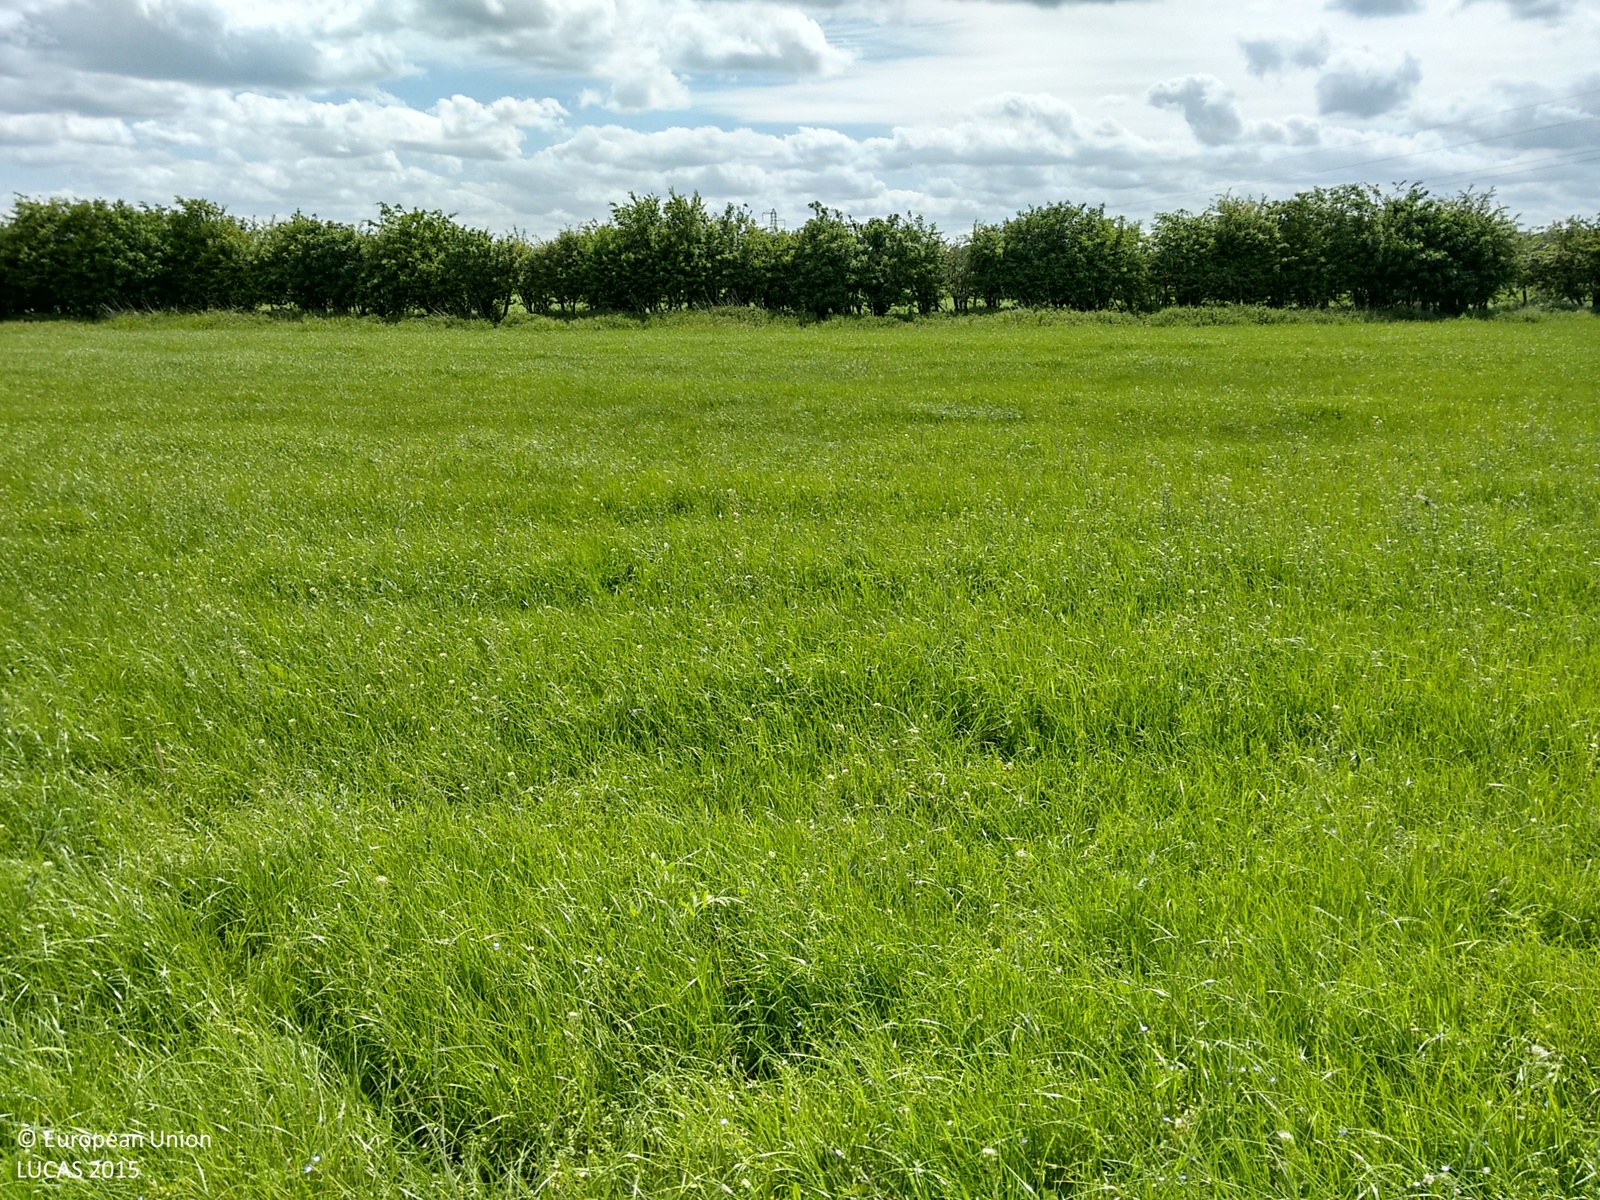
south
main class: Cropland
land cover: Temporary grasslands
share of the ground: > 75 %
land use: Agriculture (excluding fallow land and kitchen gardens)
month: May
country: GB
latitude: 52.1903
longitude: -0.6157
